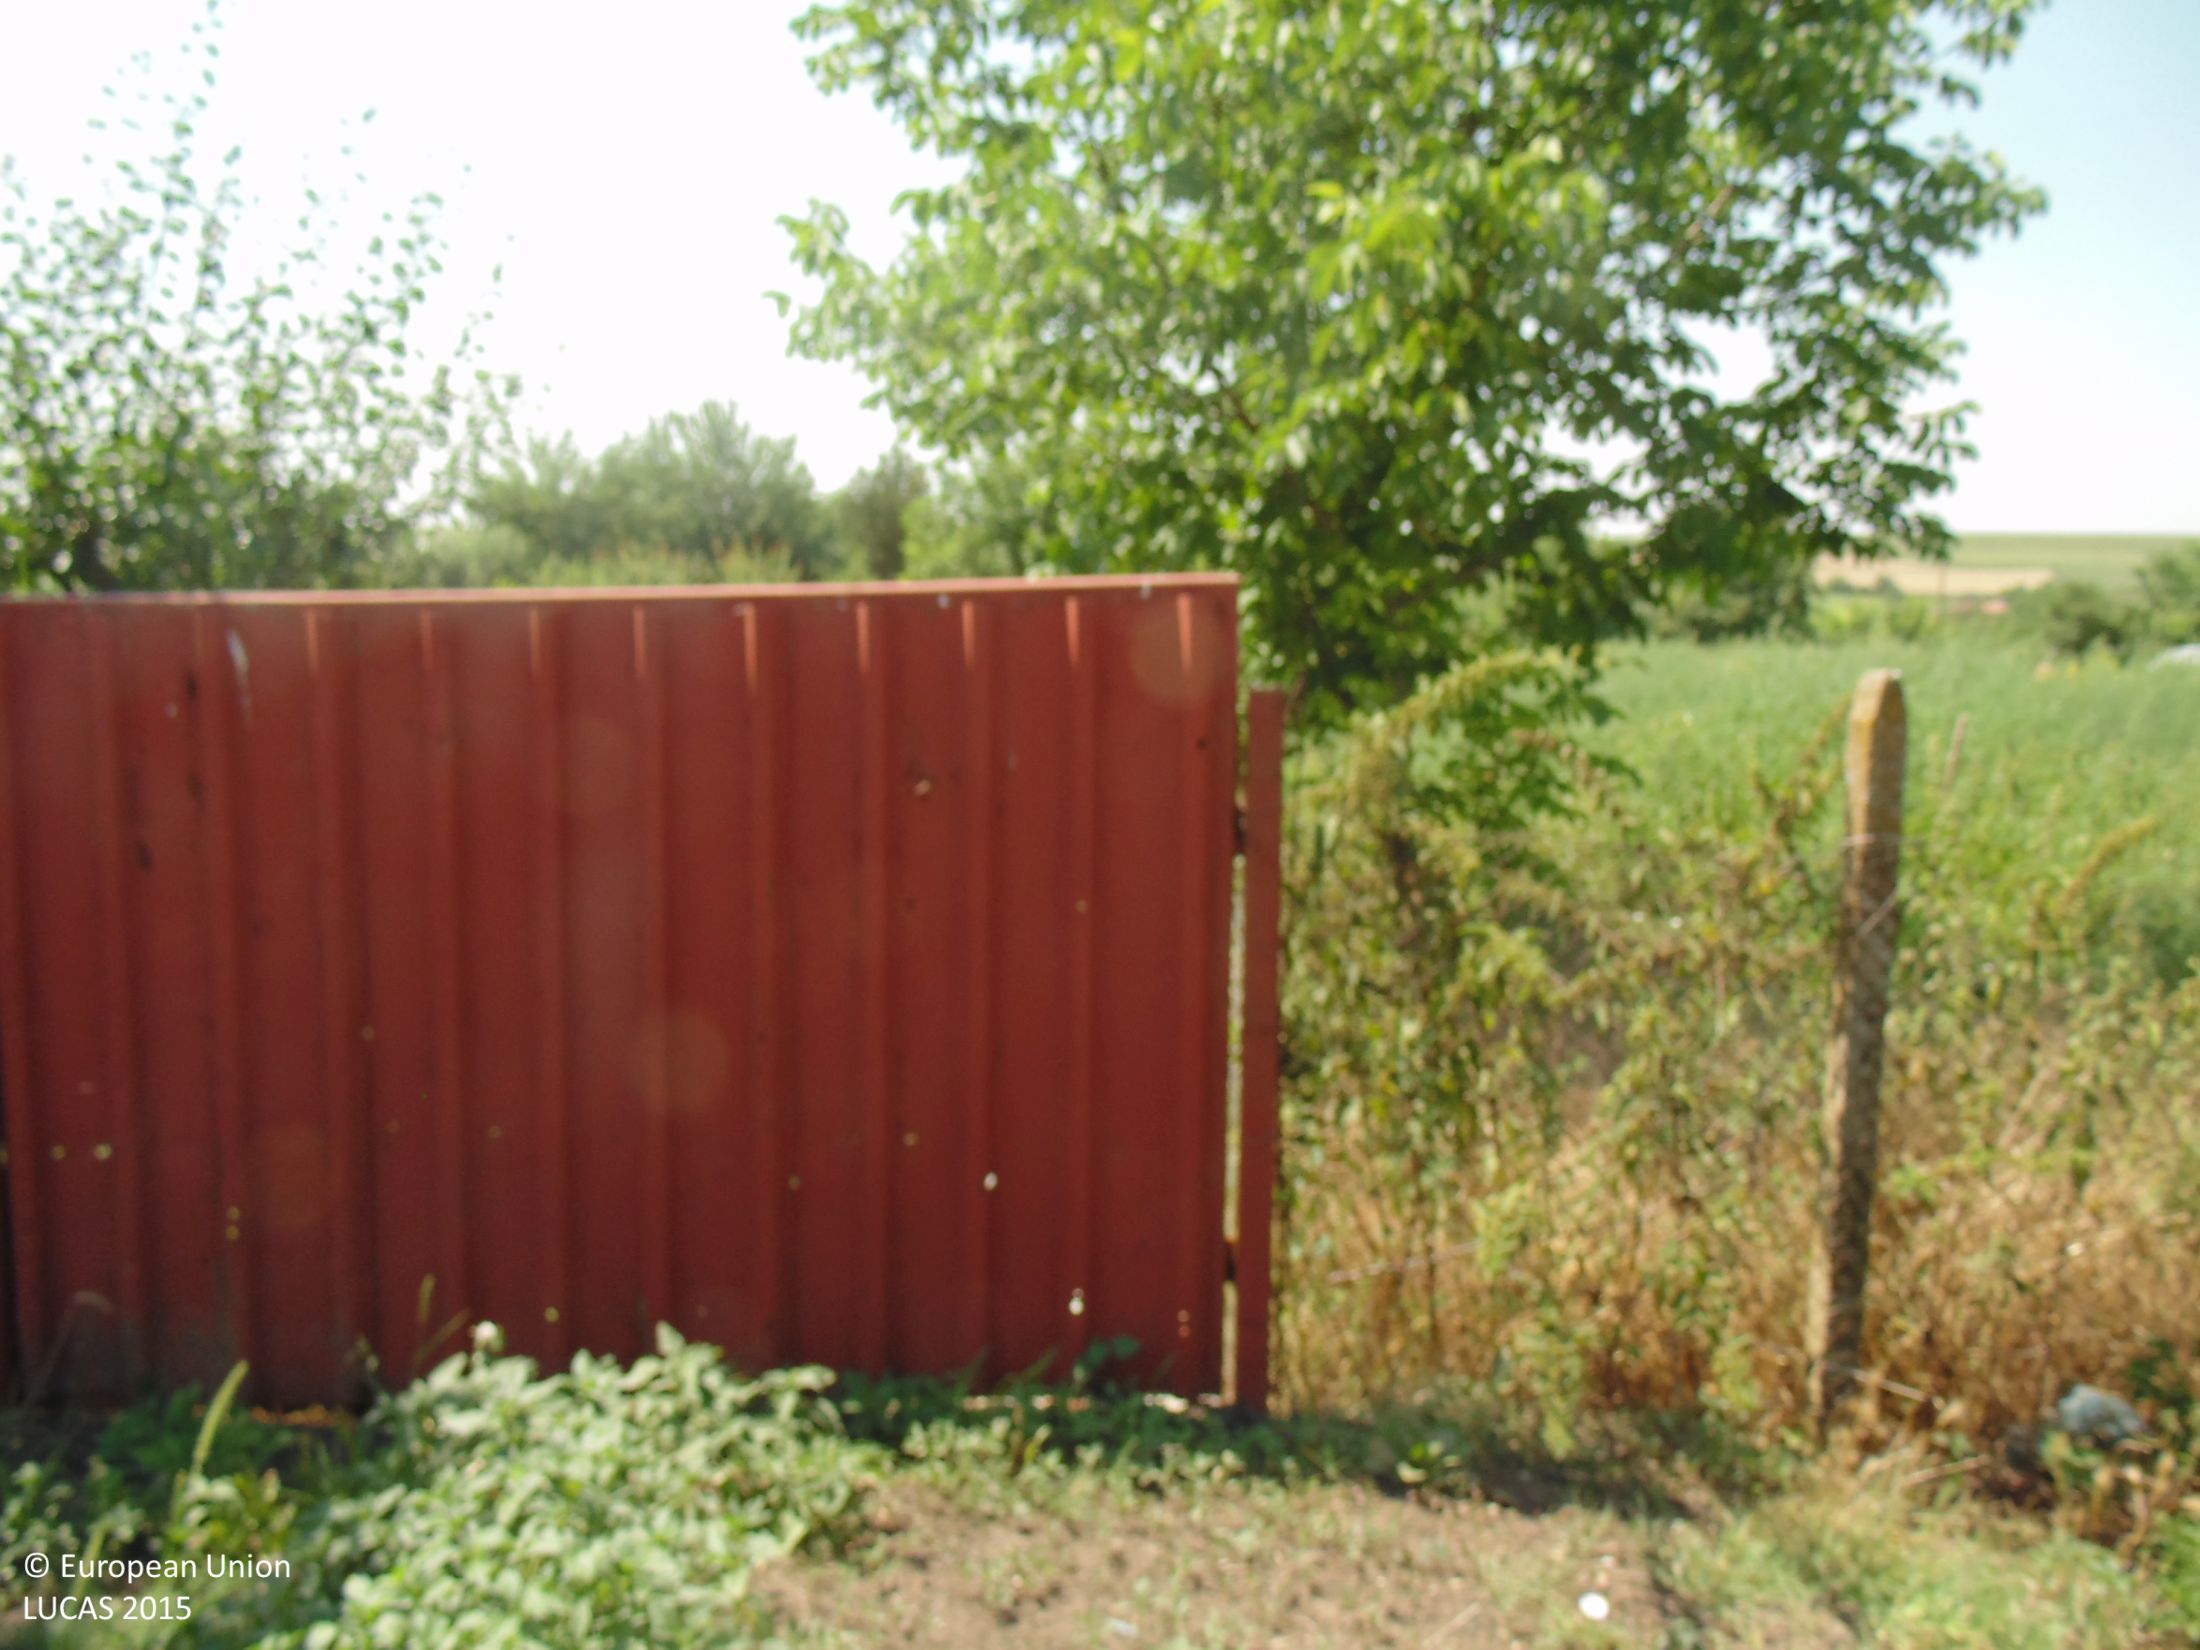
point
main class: Grassland
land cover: Grassland with sparse tree/shrub cover
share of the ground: 50 - 75 %
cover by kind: herbaceous plants 65 %, unconsolidated bare surface 25 %, broadleaved forest trees 5 %, shrubs 5 %
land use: Residential
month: July
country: BG
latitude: 43.6511
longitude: 27.6564
